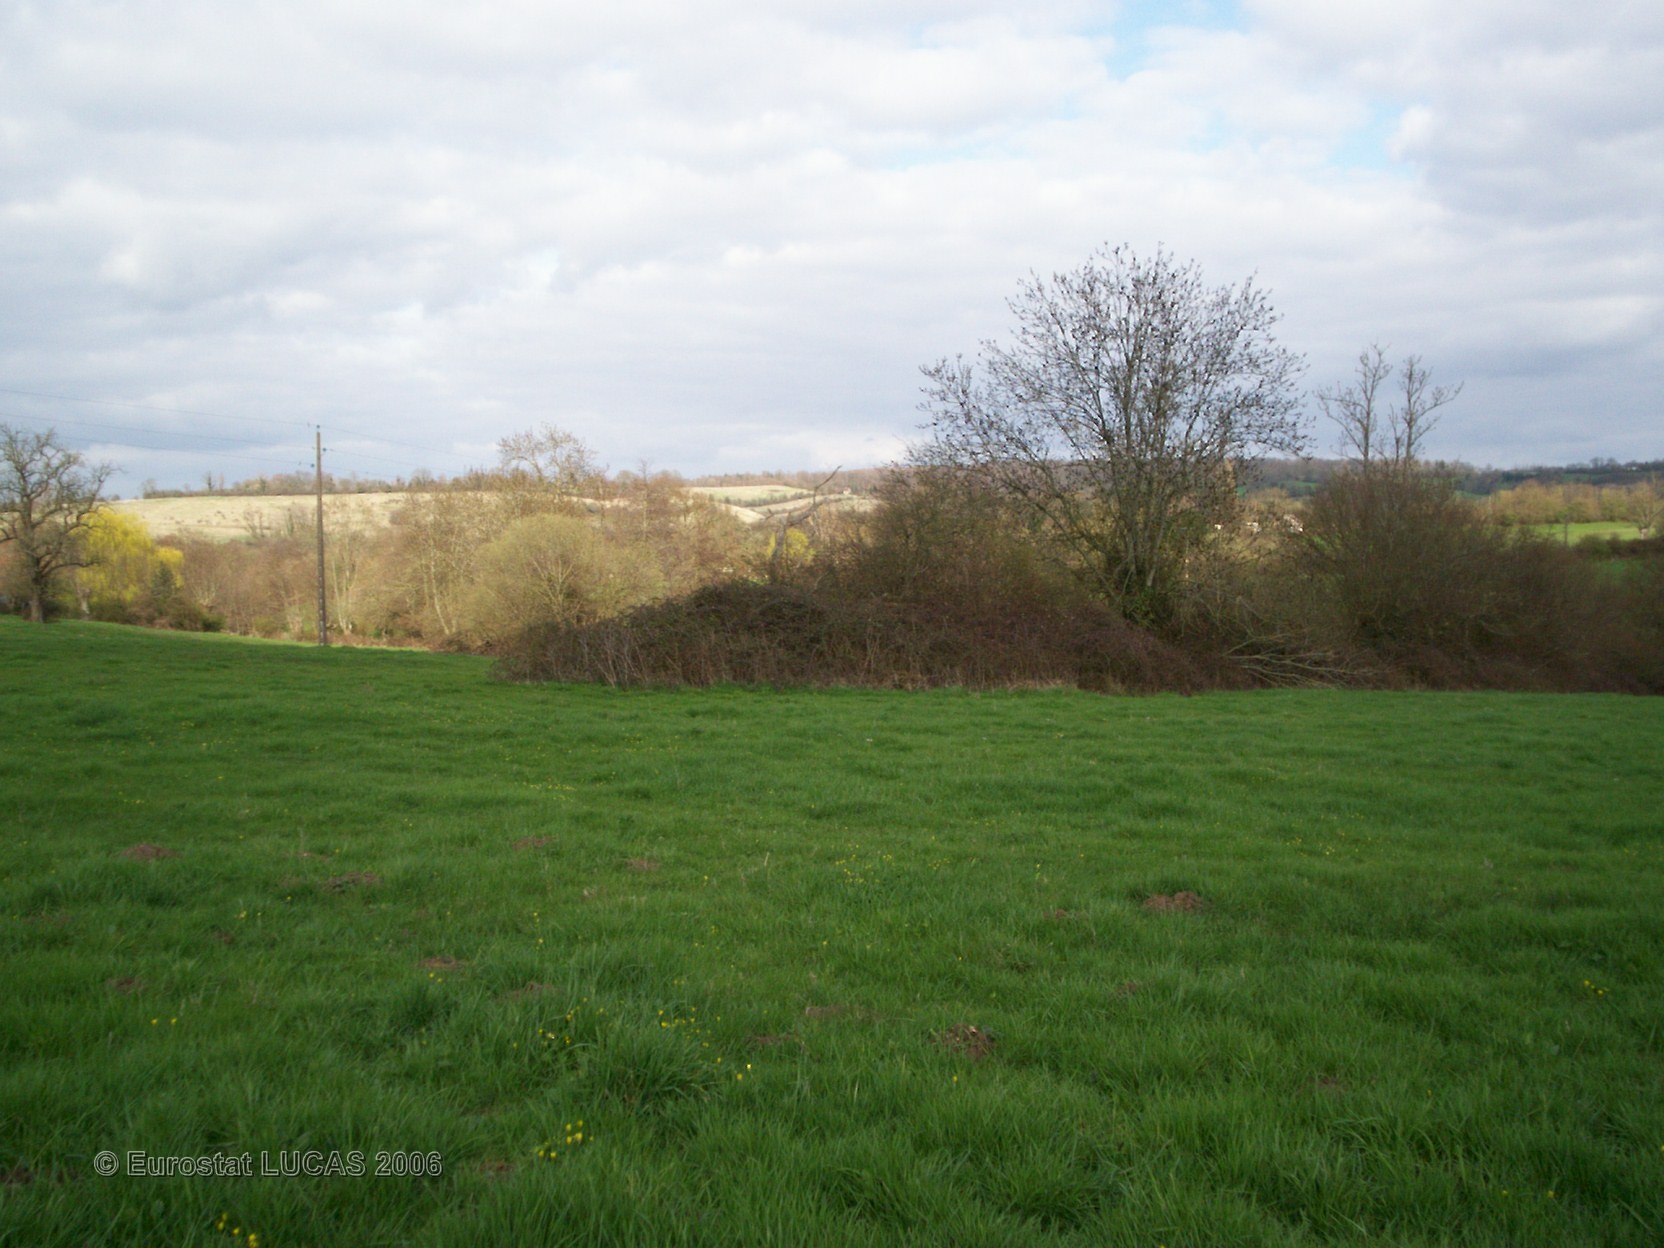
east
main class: Grassland
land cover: Grassland without tree/shrub cover
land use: Agriculture (excluding fallow land and kitchen gardens)
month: April
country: FR
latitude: 48.8989
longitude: 0.0804
